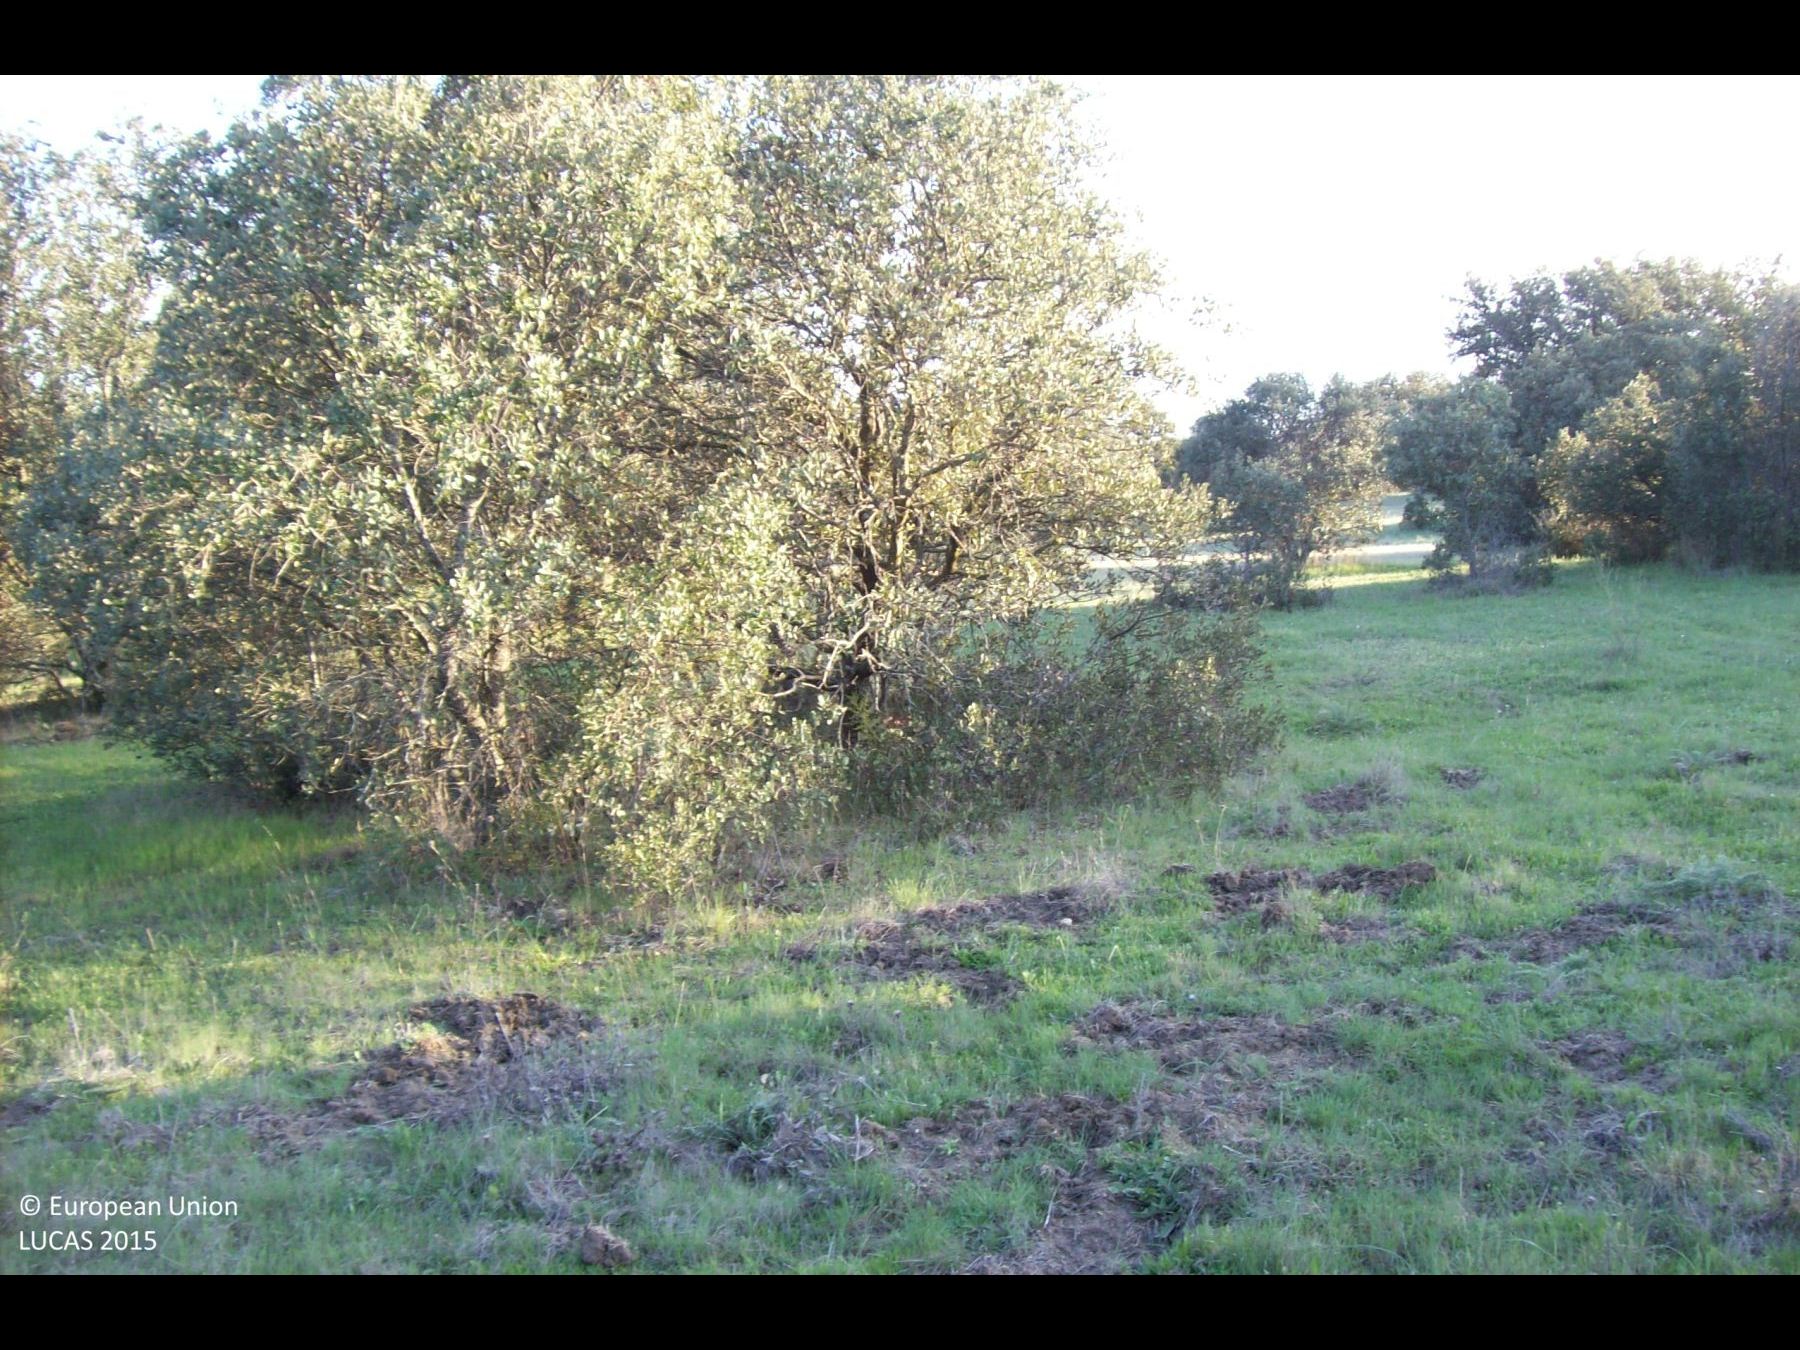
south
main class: Woodland
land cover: Broadleaved woodland
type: broadleaved evergreen forest
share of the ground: 25 - 50 %
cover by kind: herbaceous plants 55 %, broadleaved forest trees 45 %
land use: Forestry
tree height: < 5 m
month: April
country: ES
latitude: 40.4218
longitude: -3.9366
